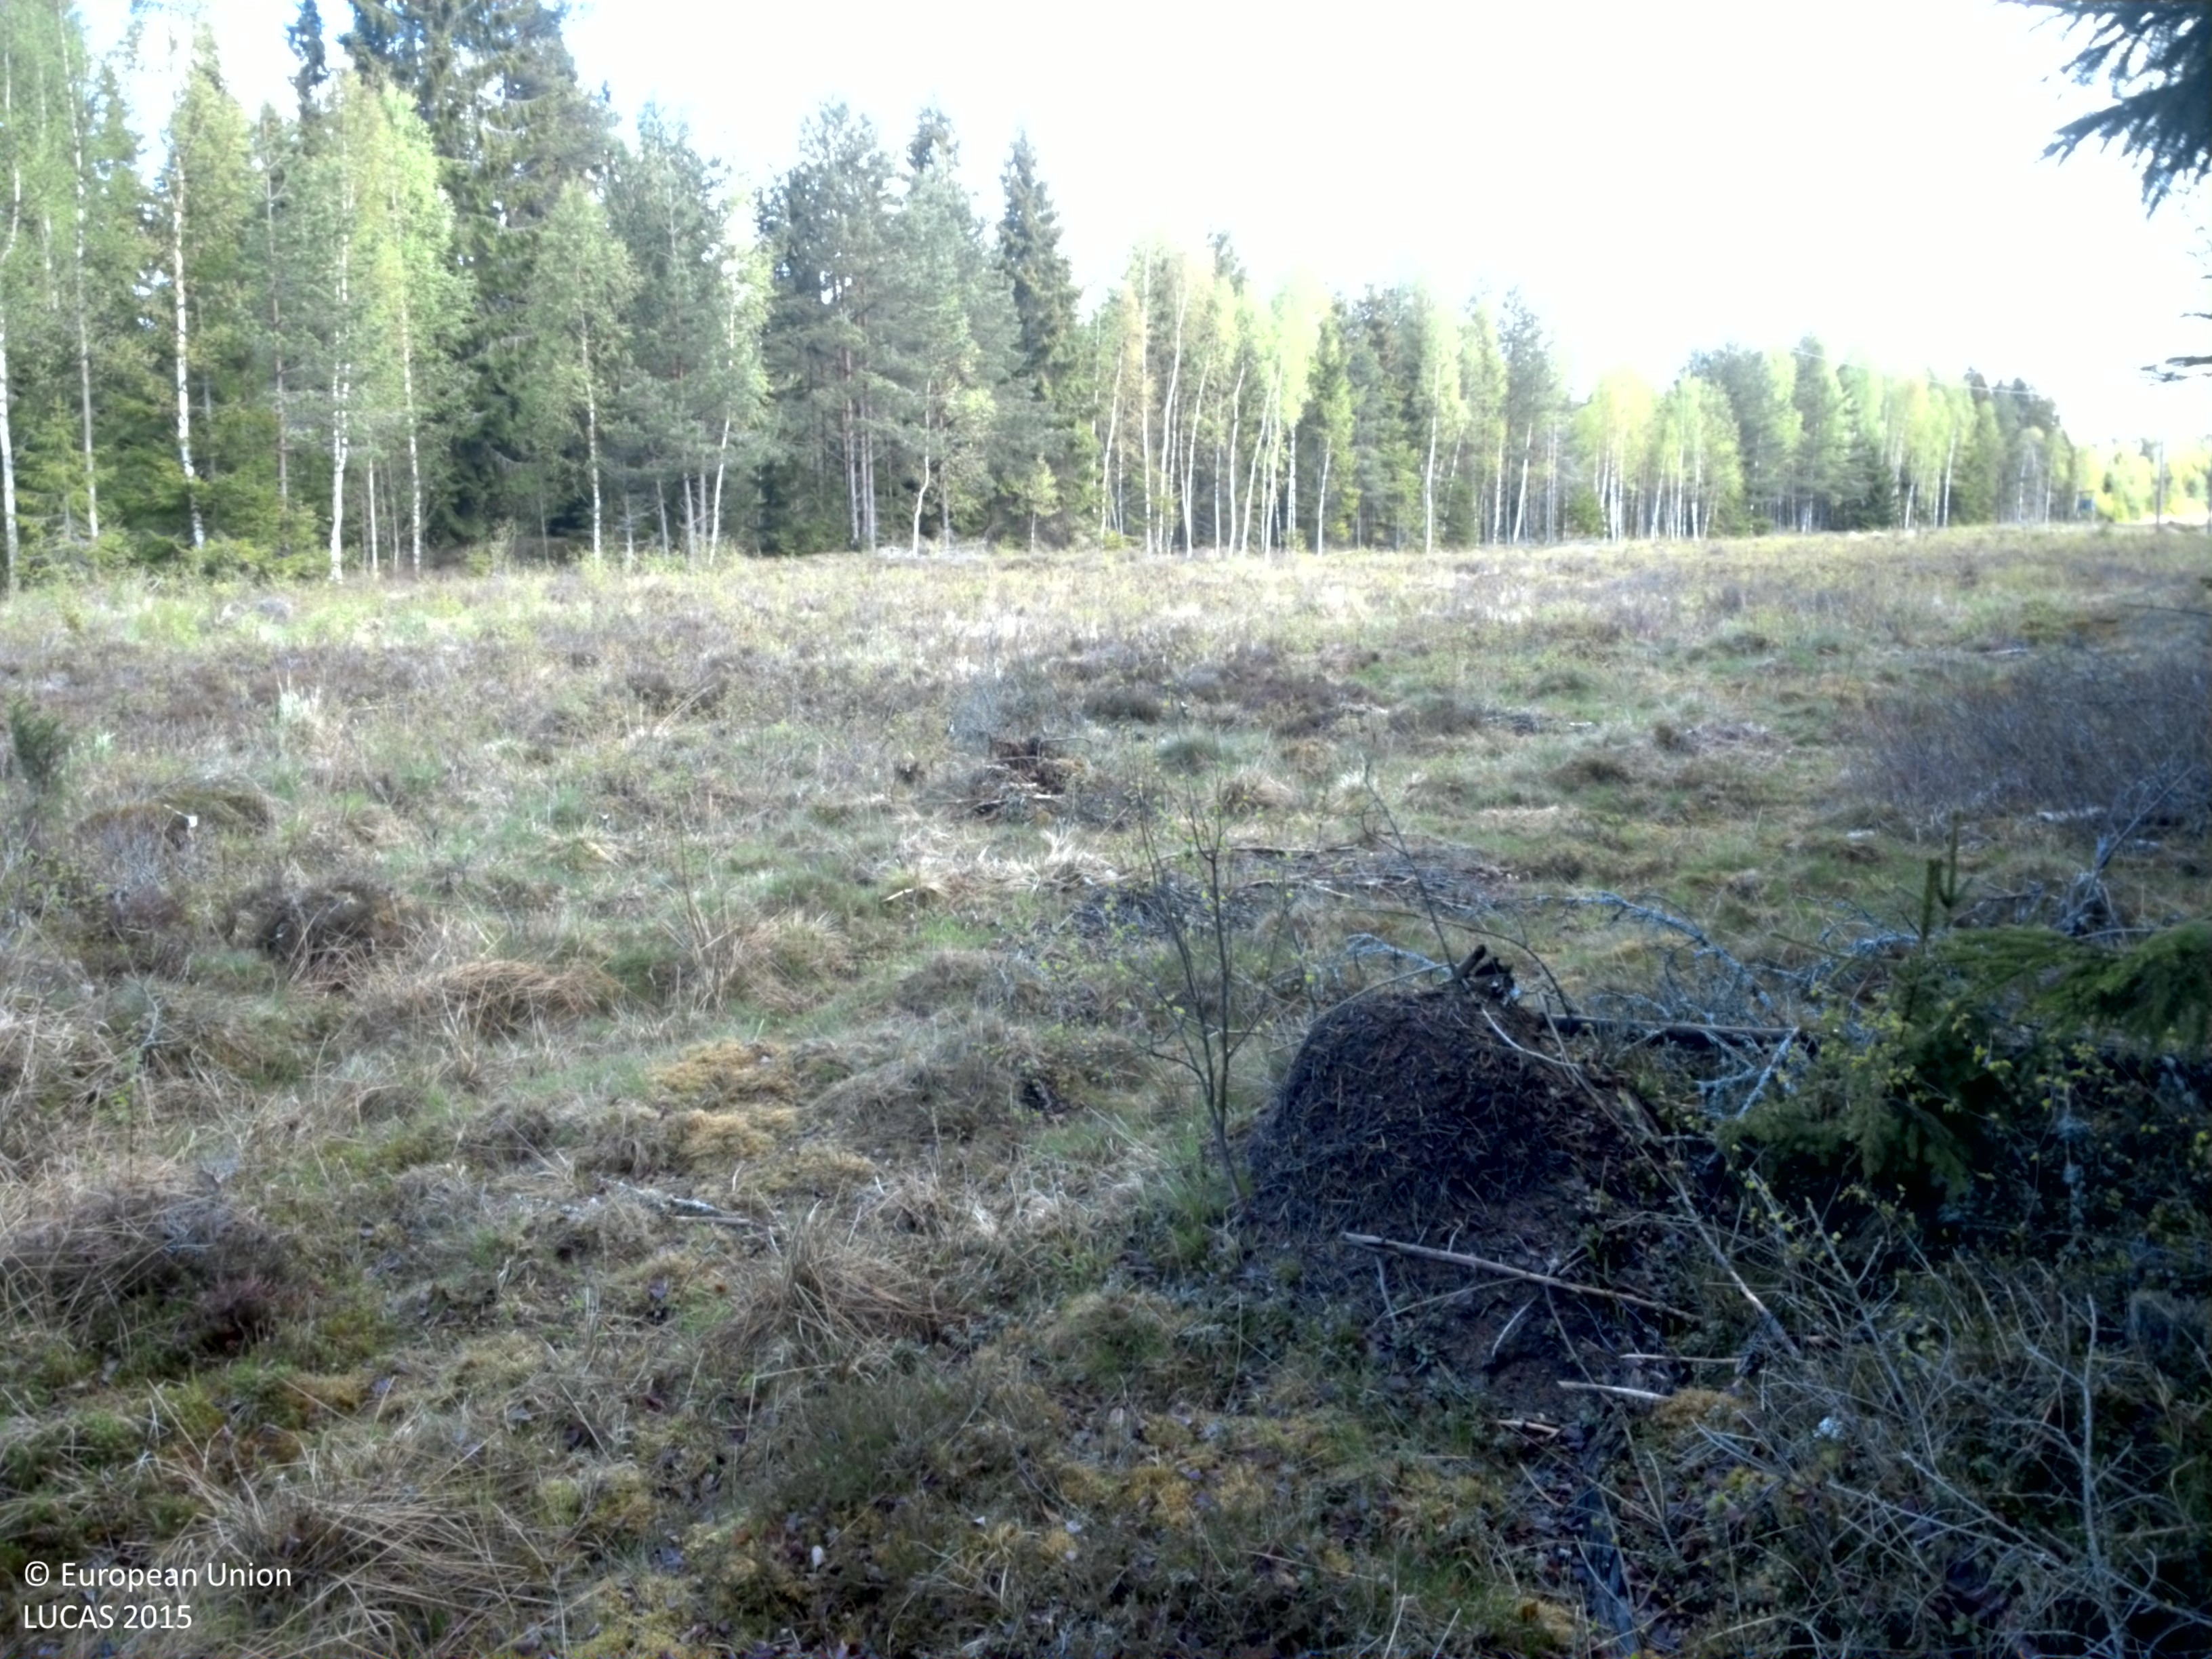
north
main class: Woodland
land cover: Broadleaved woodland
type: hemiboreal forest and nemoral coniferous forest and mixed broadleaved-coniferous forest
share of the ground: 10 - 25 %
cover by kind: herbaceous plants 50 %, shrubs 30 %, broadleaved forest trees 10 %, lichens and mosses 10 %
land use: Electricity, gas and thermal power distribution
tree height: < 5 m
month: May
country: SE
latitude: 59.2905
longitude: 14.1524
